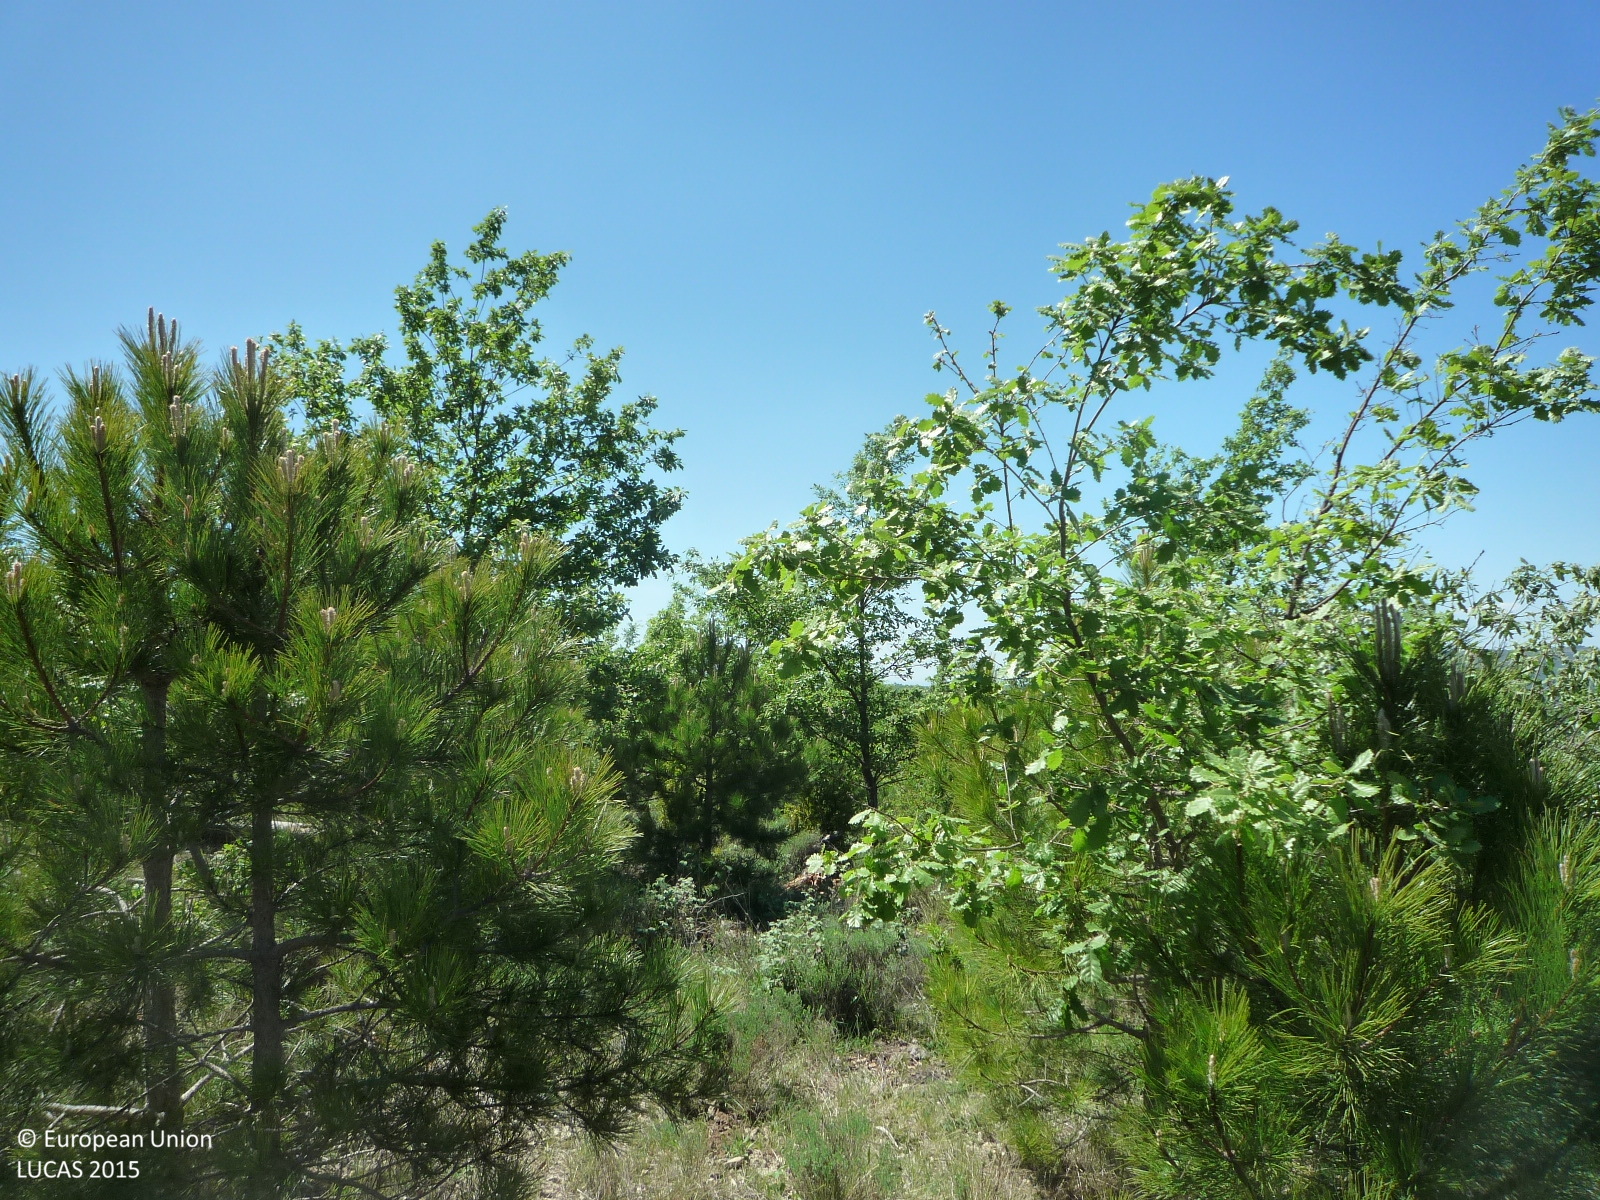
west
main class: Woodland
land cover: Other mixed woodland
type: broadleaved evergreen forest
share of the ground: > 75 %
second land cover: Spontaneously vegetated surfaces
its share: 25 - 50 %
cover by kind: herbaceous plants 40 %, broadleaved forest trees 35 %, coniferous forest trees 25 %
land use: Forestry
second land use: Agriculture (excluding fallow land and kitchen gardens)
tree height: < 5 m
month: May
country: ES
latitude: 41.7965
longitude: 1.6020
